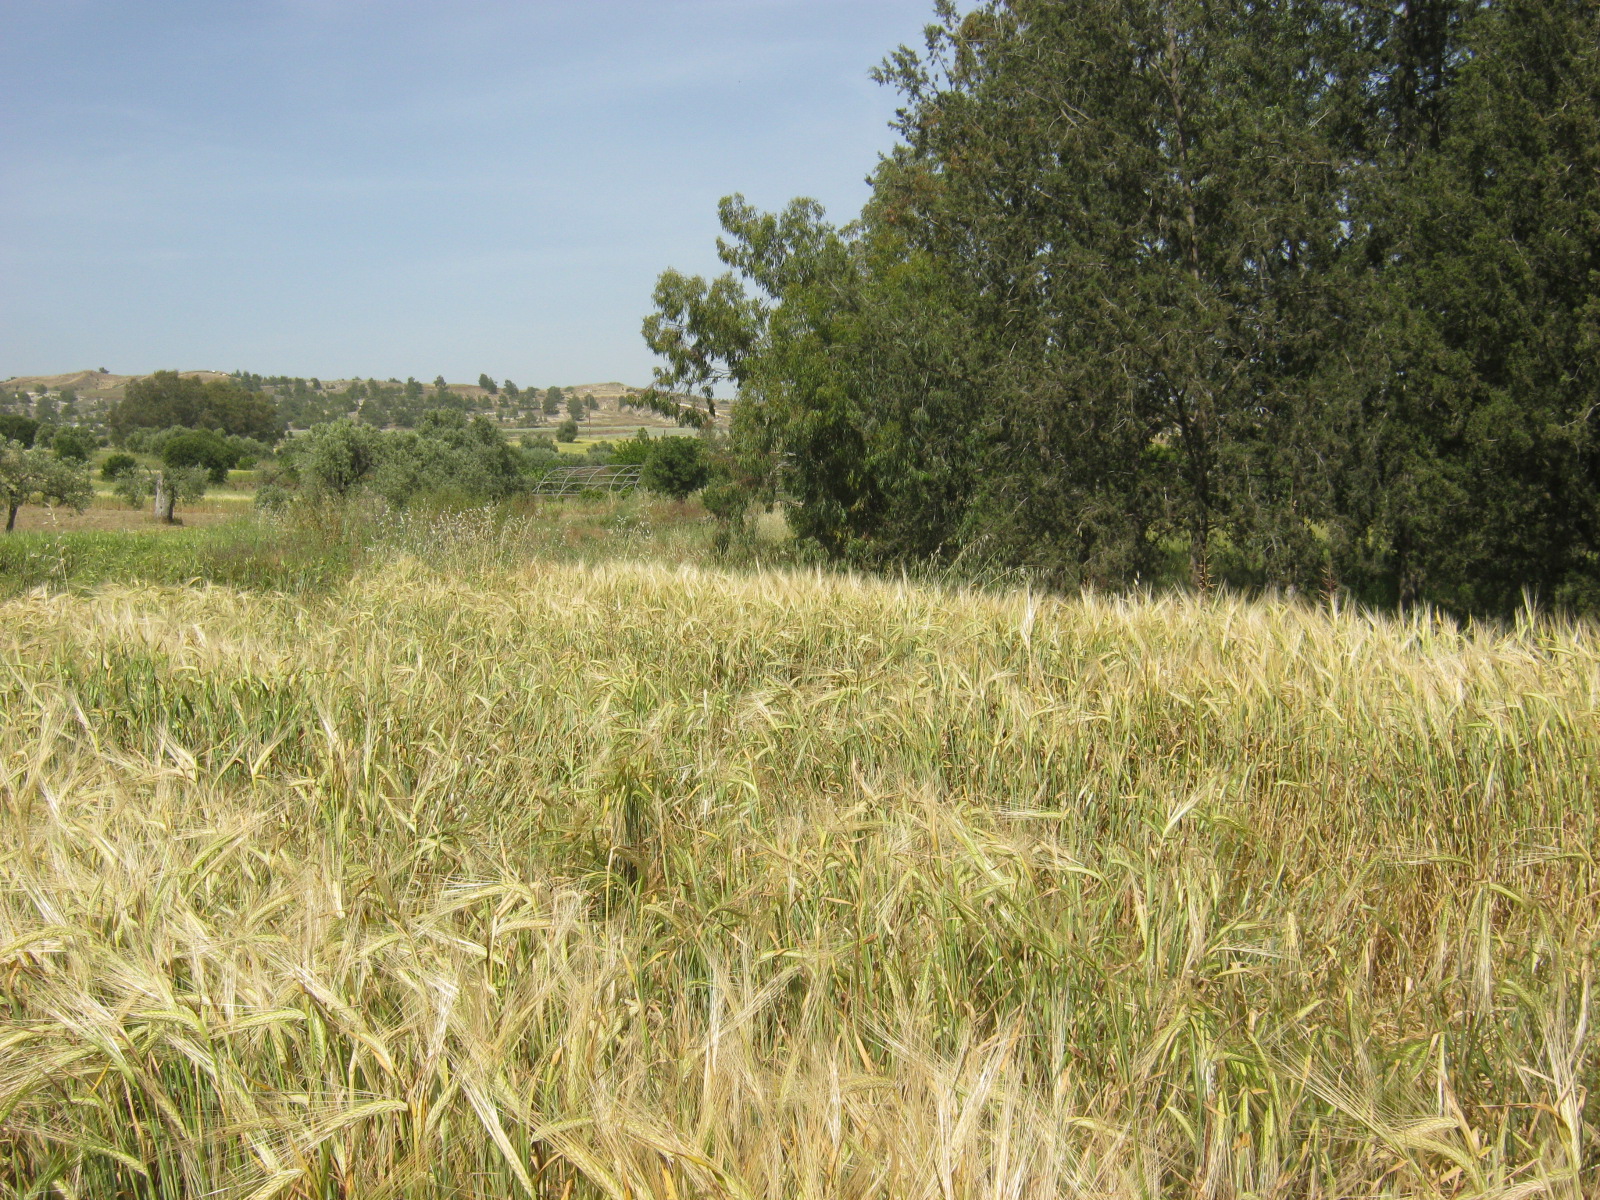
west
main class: Cropland
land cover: Barley
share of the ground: > 75 %
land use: Agriculture (excluding fallow land and kitchen gardens)
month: May
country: CY
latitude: 35.0335
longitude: 33.2358
